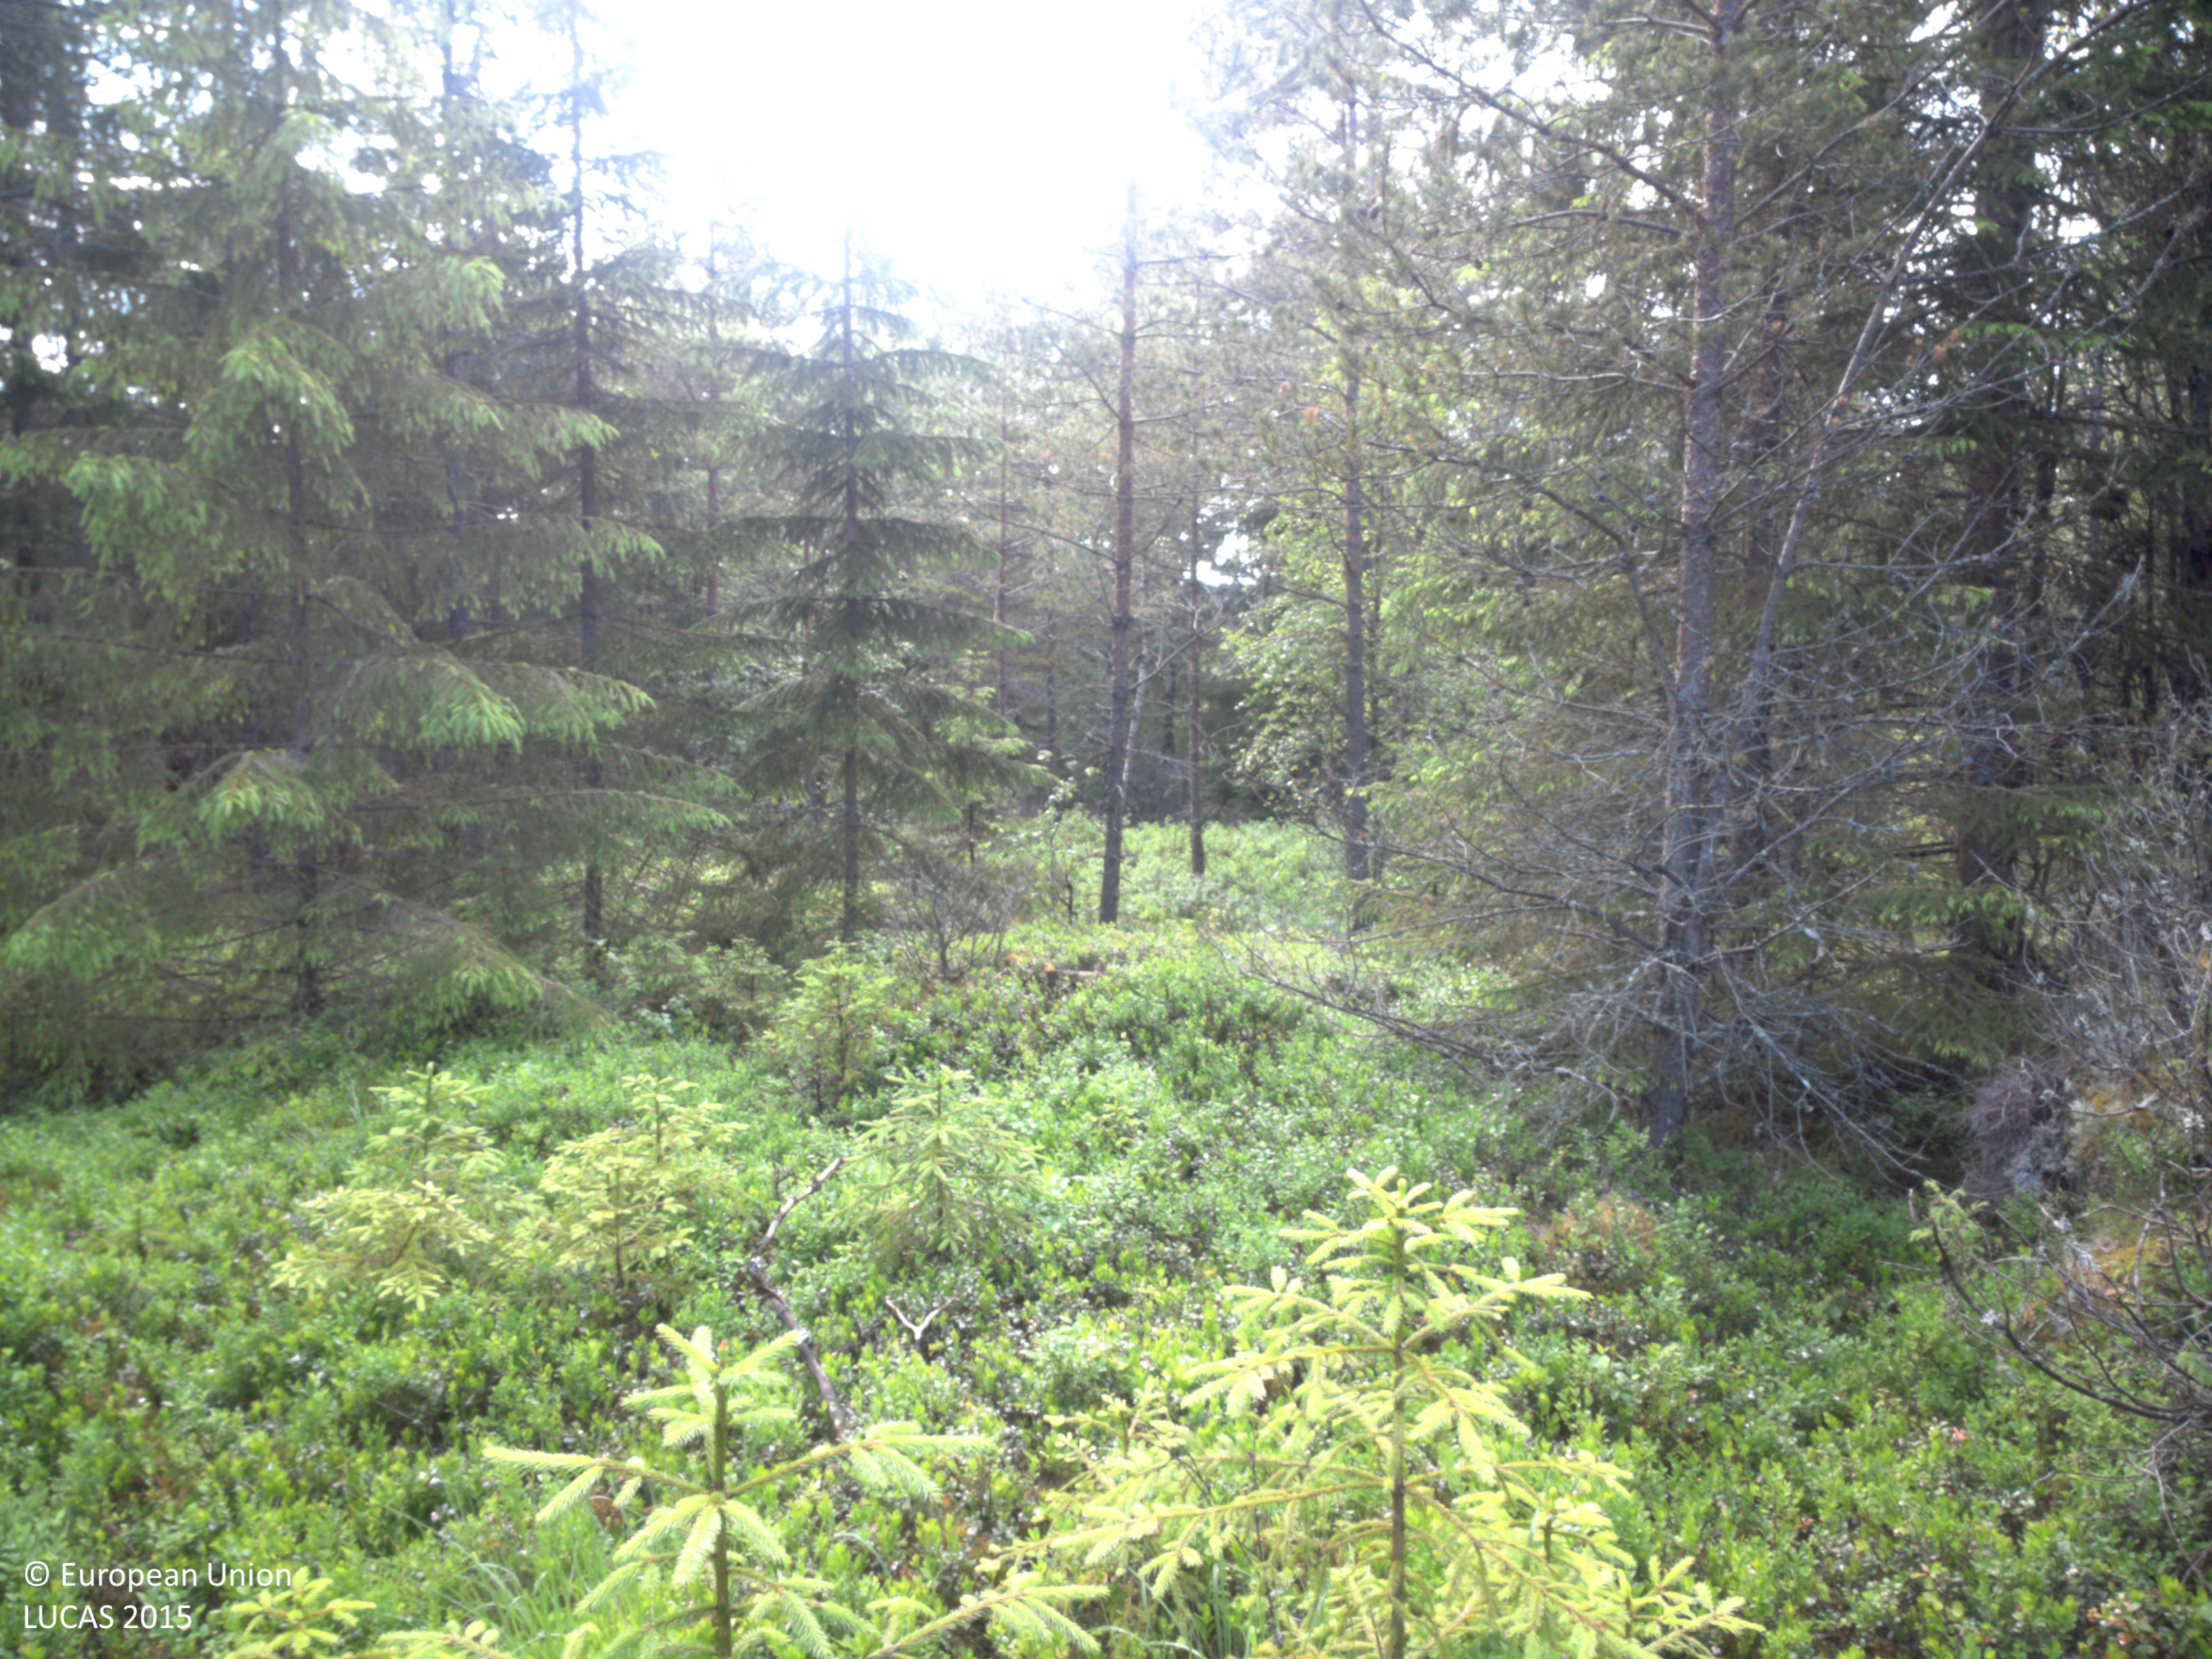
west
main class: Woodland
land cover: Other mixed woodland
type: boreal forest
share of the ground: 50 - 75 %
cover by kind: coniferous forest trees 50 %, herbaceous plants 30 %, broadleaved forest trees 20 %
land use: Forestry
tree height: > 5 m
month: June
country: SE
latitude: 58.8575
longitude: 11.6085
